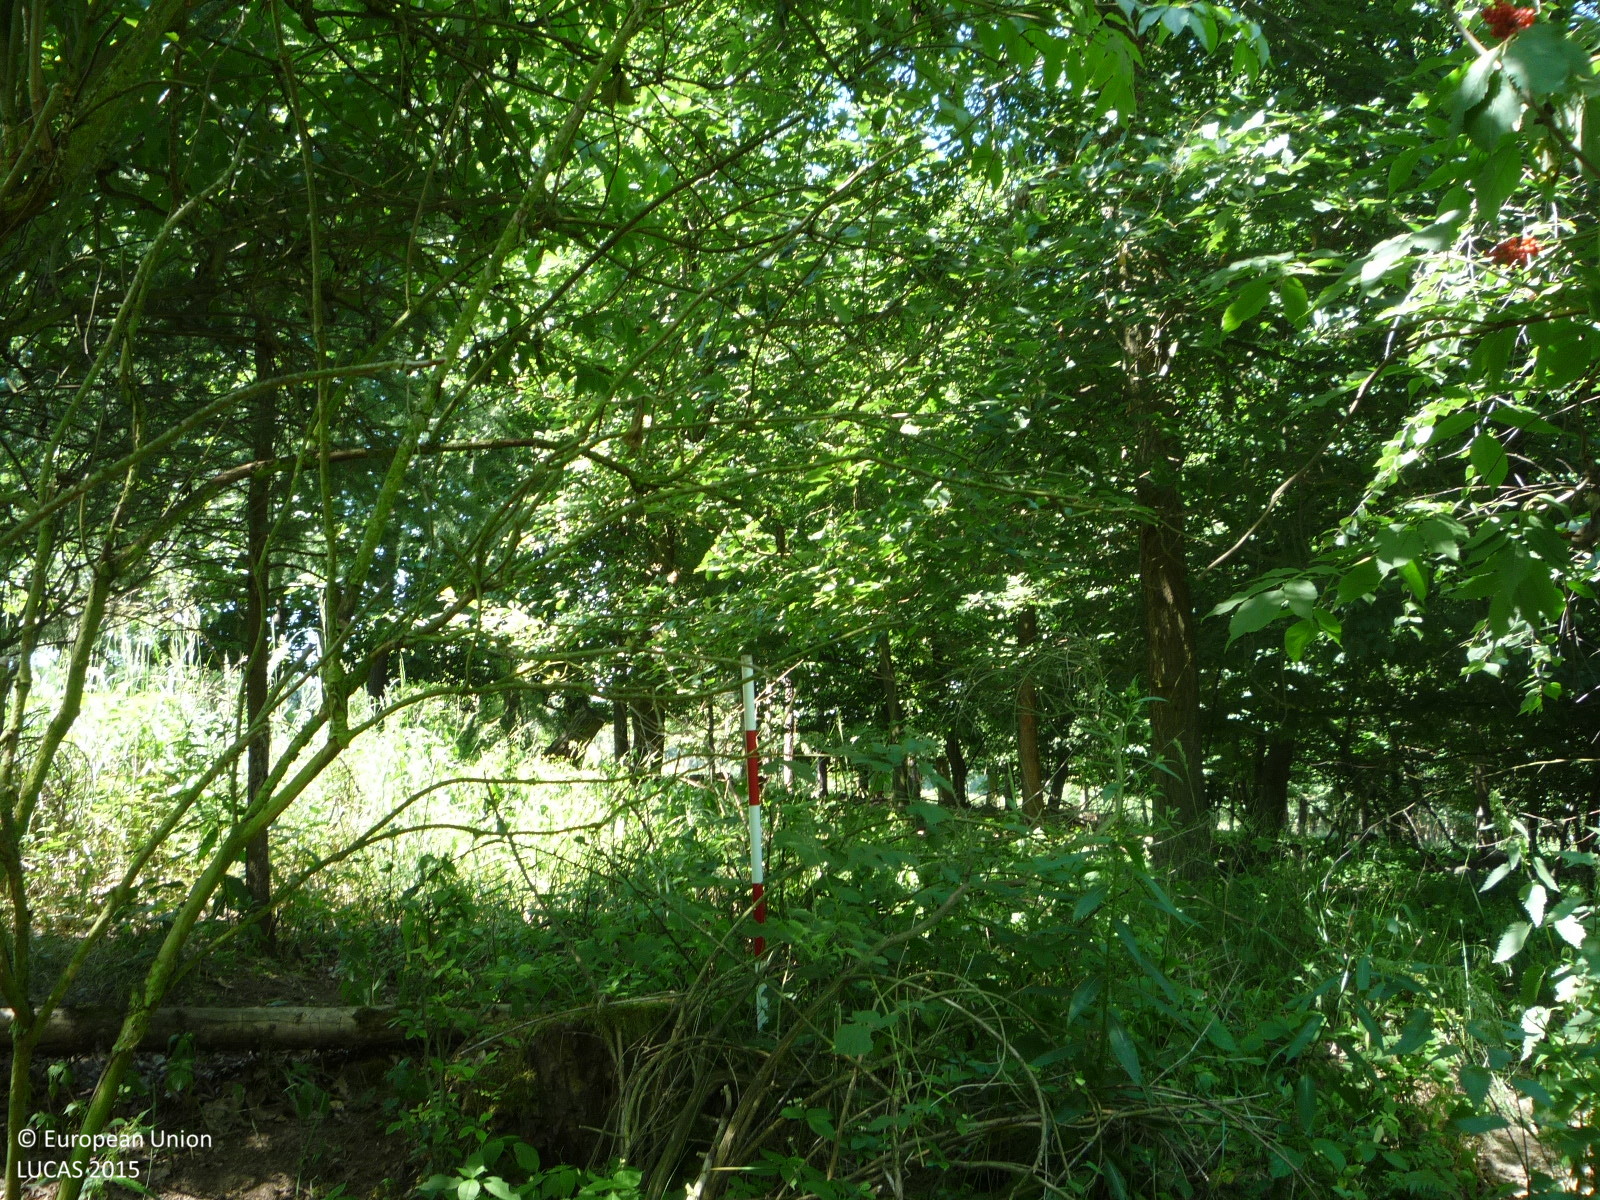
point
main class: Woodland
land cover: Broadleaved woodland
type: mesophytic deciduous forest
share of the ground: > 75 %
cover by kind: broadleaved forest trees 85 %, shrubs 10 %, herbaceous plants 5 %
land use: Semi-natural and natural areas not in use
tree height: > 5 m
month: July
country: CZ
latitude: 50.4200
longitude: 14.4915
